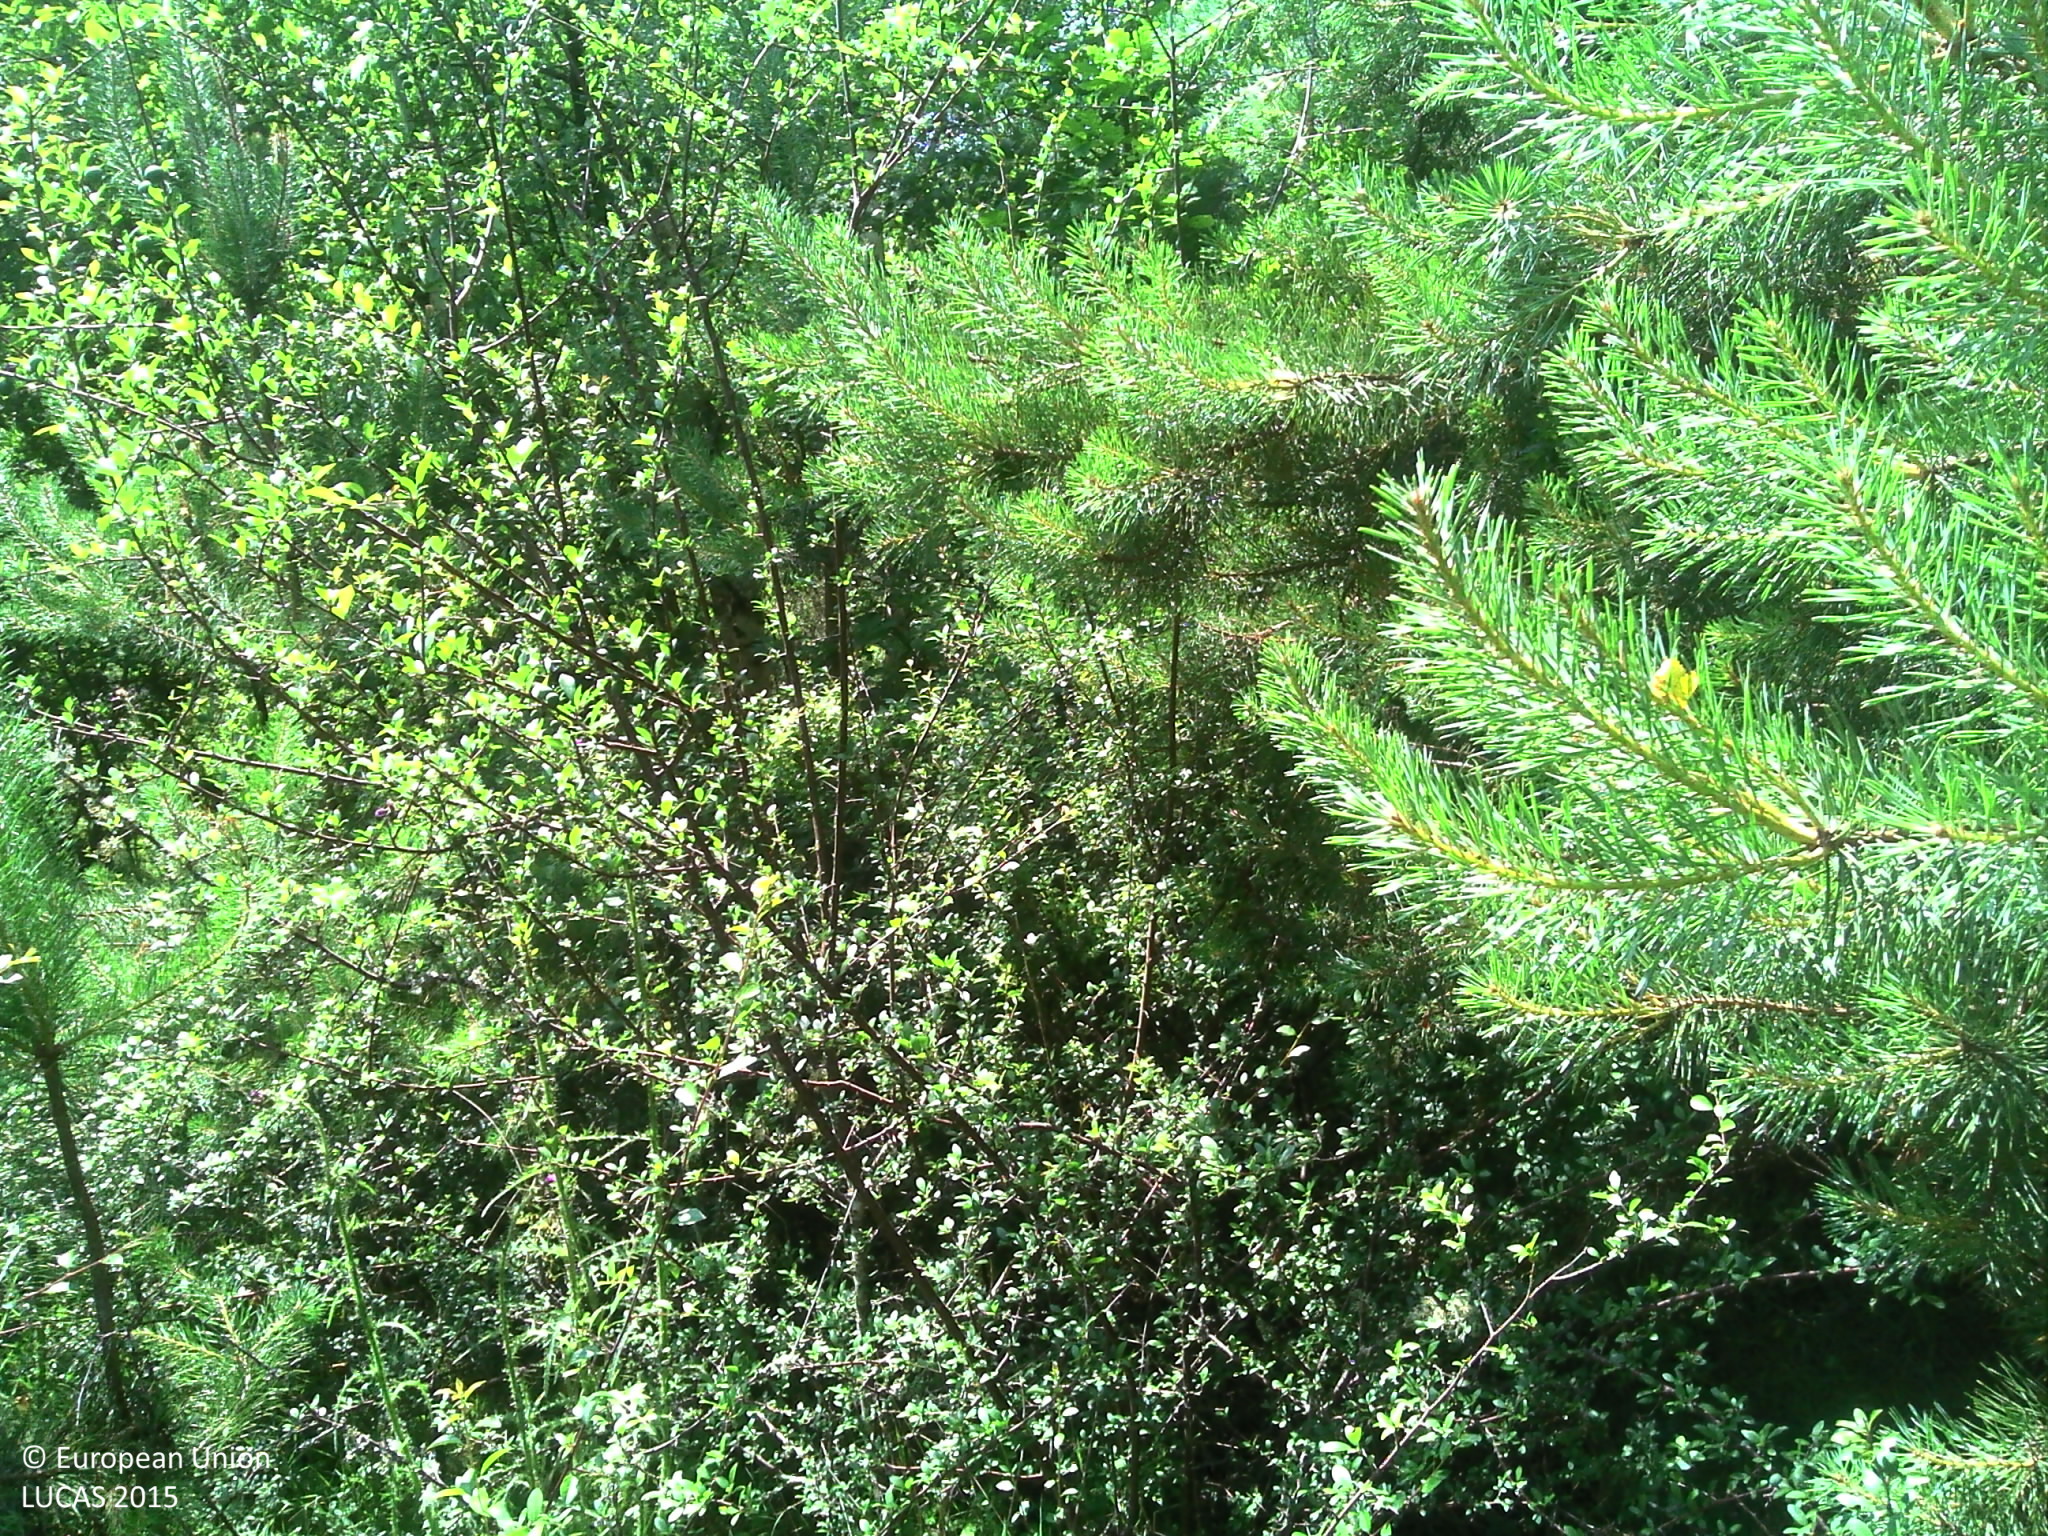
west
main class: Woodland
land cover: Pine dominated mixed woodland
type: thermophilous deciduous forest
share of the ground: > 75 %
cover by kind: coniferous forest trees 30 %, broadleaved forest trees 30 %, herbaceous plants 20 %, unconsolidated bare surface 20 %
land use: Forestry
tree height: > 5 m
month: June
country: FR
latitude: 47.6622
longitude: 2.0124
